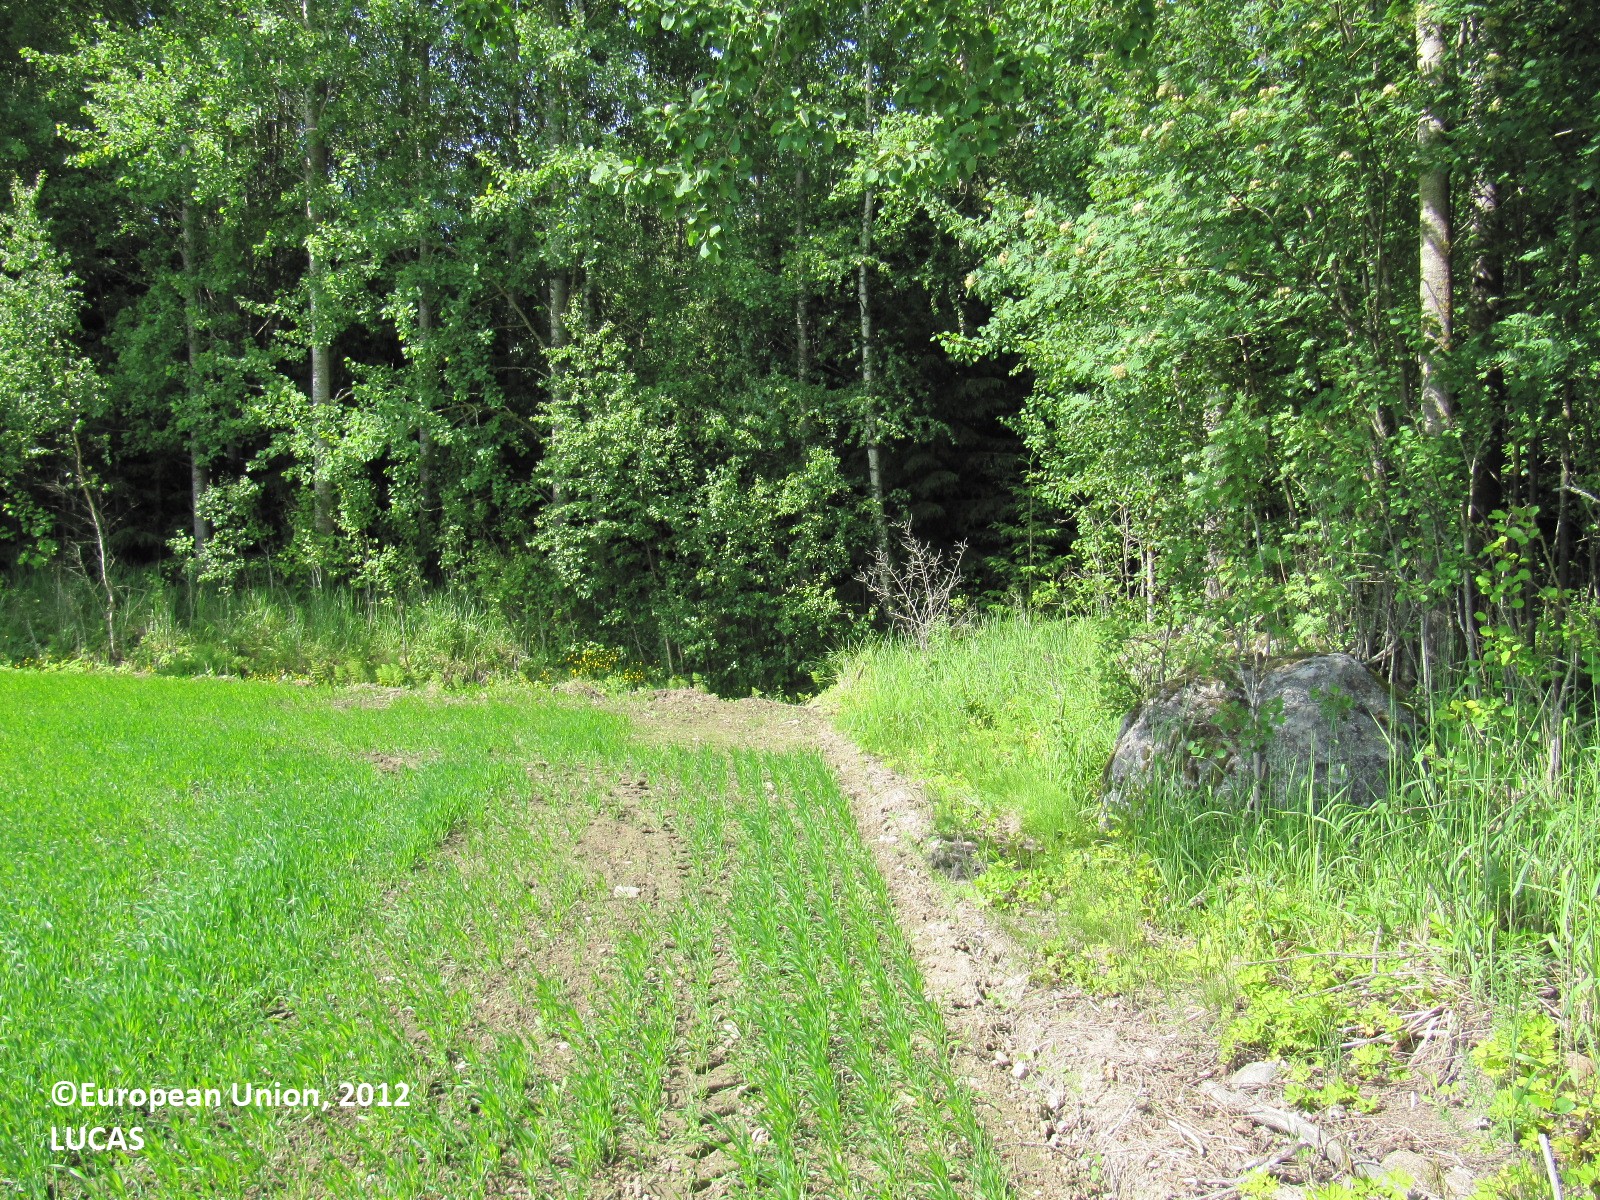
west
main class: Cropland
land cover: Sugar beet
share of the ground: 50 - 75 %
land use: Agriculture (excluding fallow land and kitchen gardens)
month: June
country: FI
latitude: 59.9667
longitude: 22.9233
